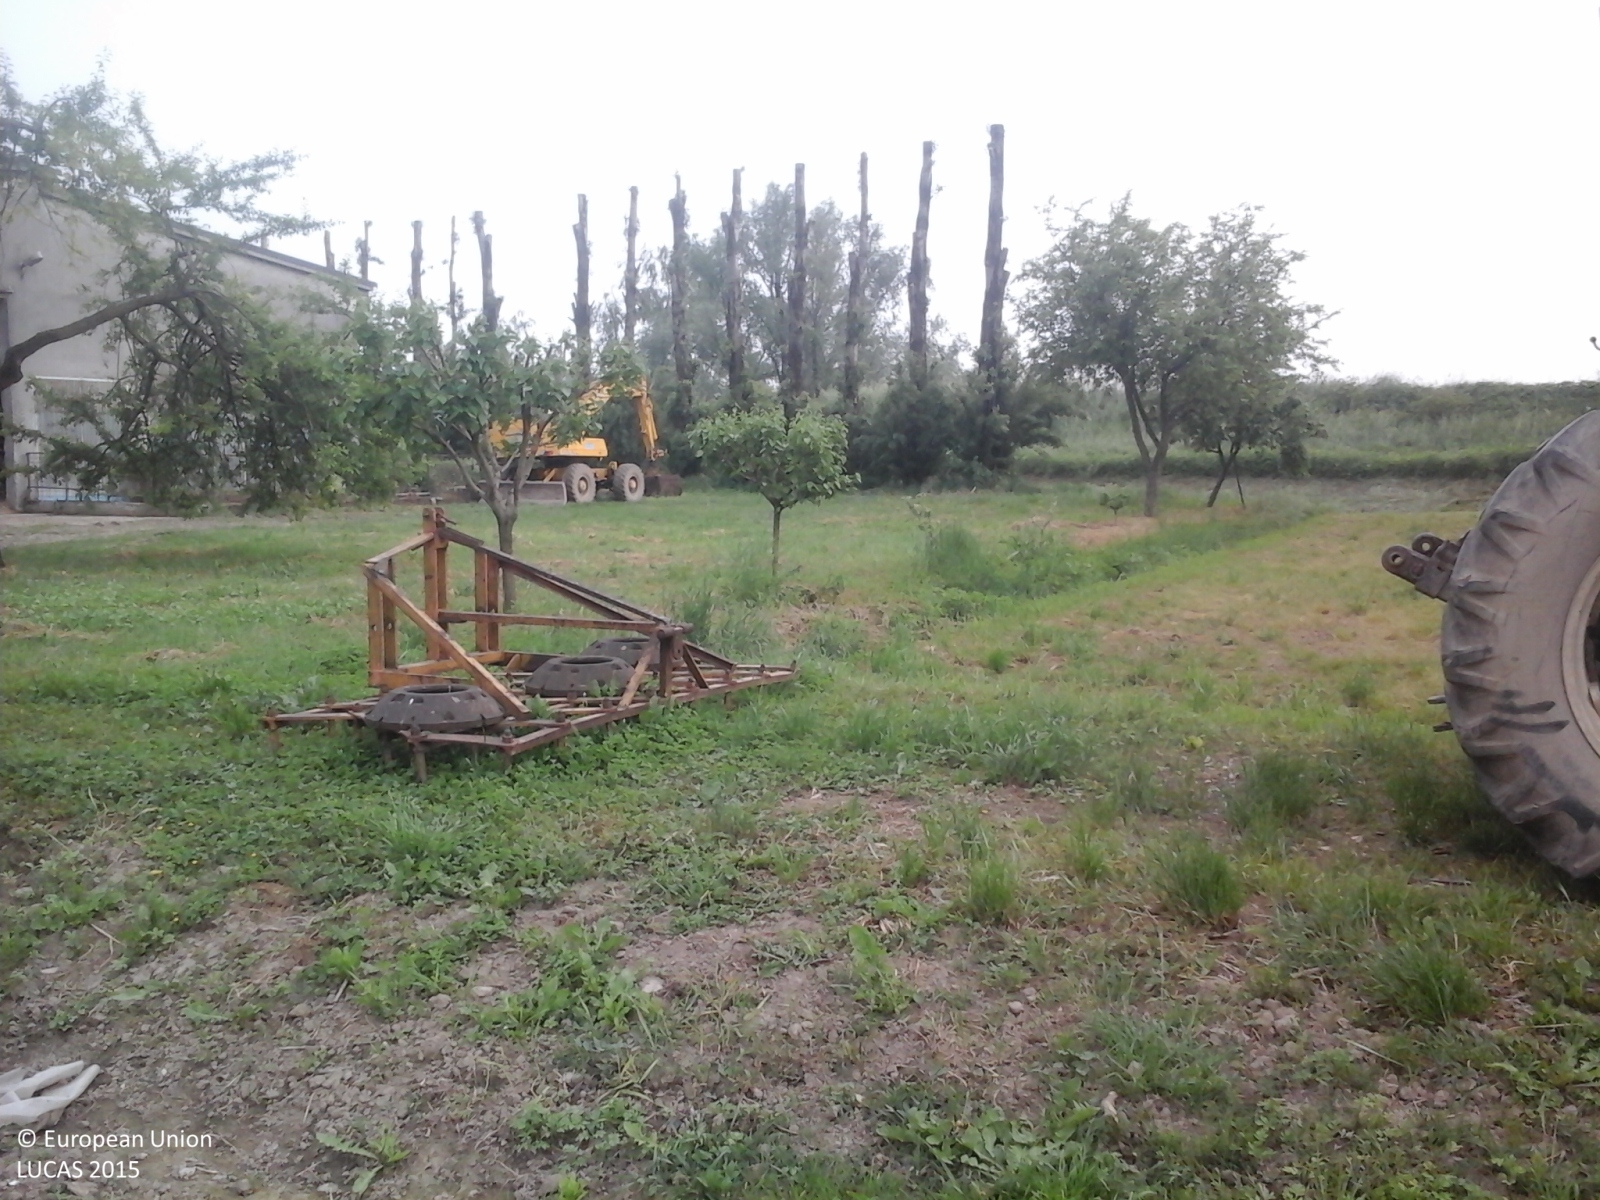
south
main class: Cropland
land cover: Other fresh vegetables
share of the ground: < 10 %
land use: Kitchen garden
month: May
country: IT
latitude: 45.1795
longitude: 10.3175
